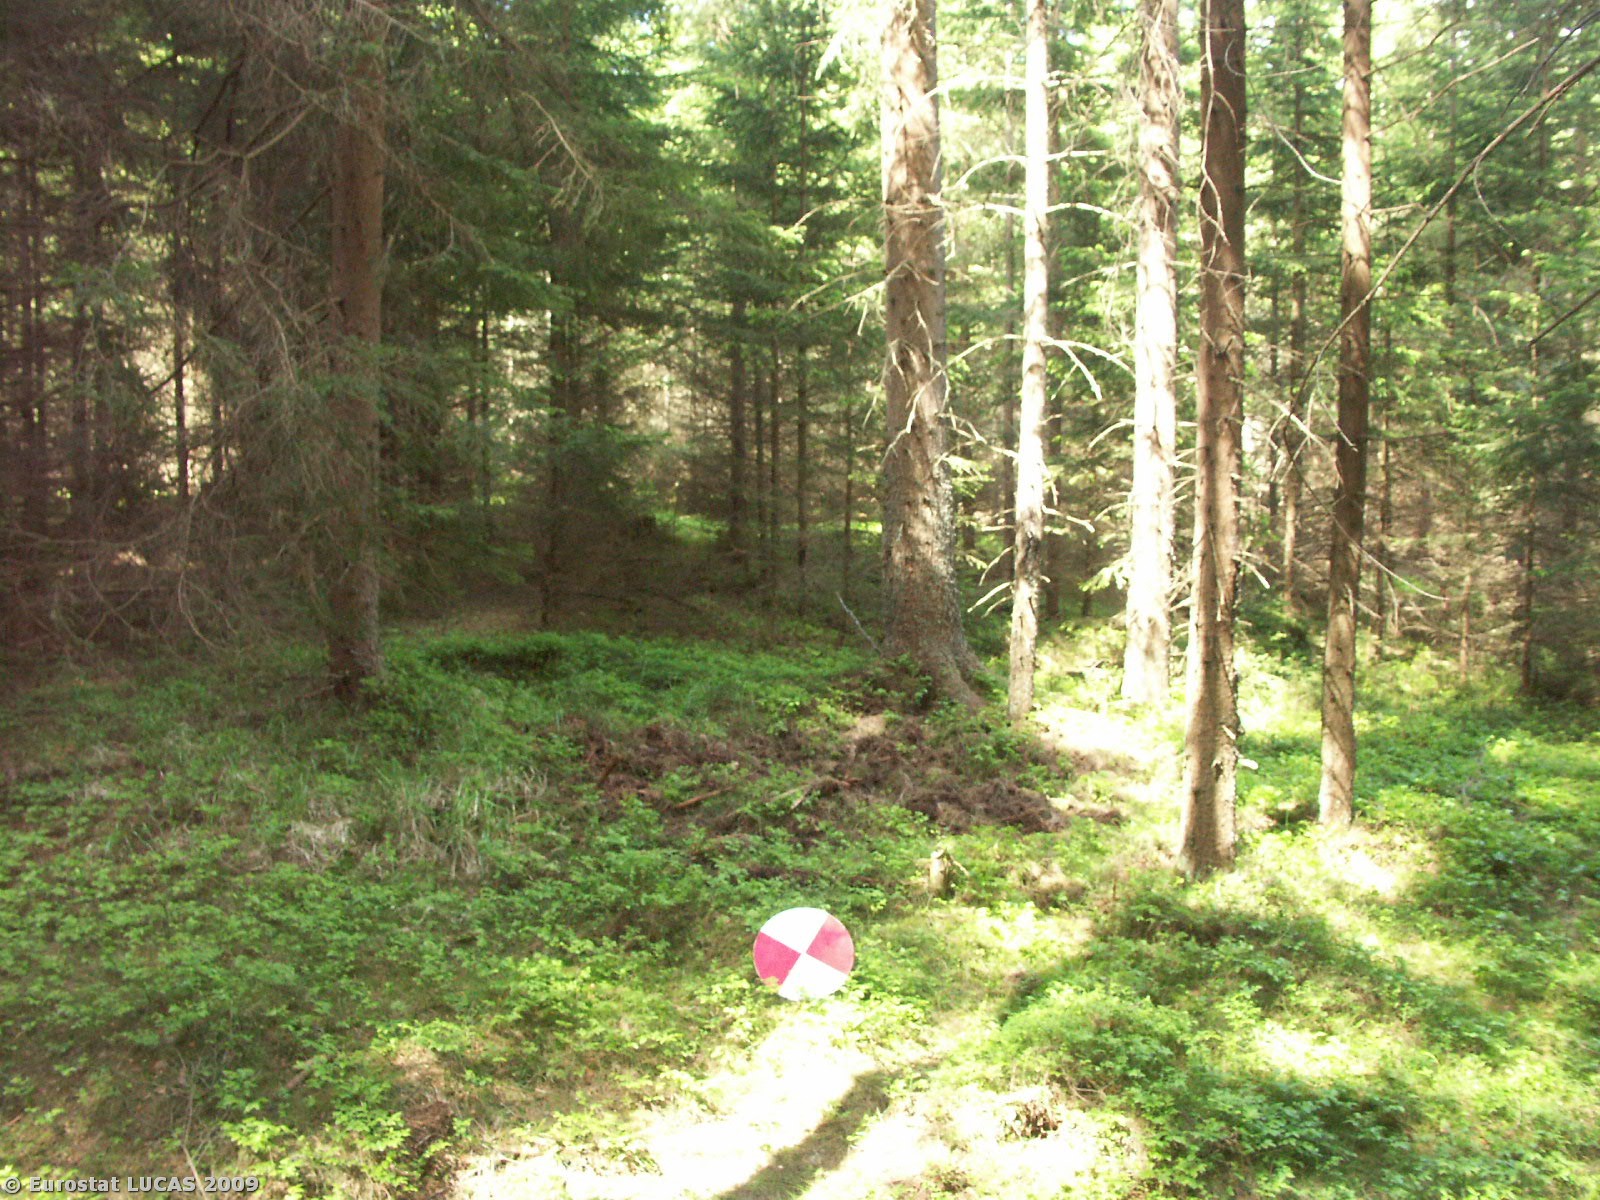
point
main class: Woodland
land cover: Coniferous woodland
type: hemiboreal forest and nemoral coniferous forest and mixed broadleaved-coniferous forest
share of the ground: > 75 %
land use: Forestry
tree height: > 5 m
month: May
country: CZ
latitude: 48.6490
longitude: 14.6296
